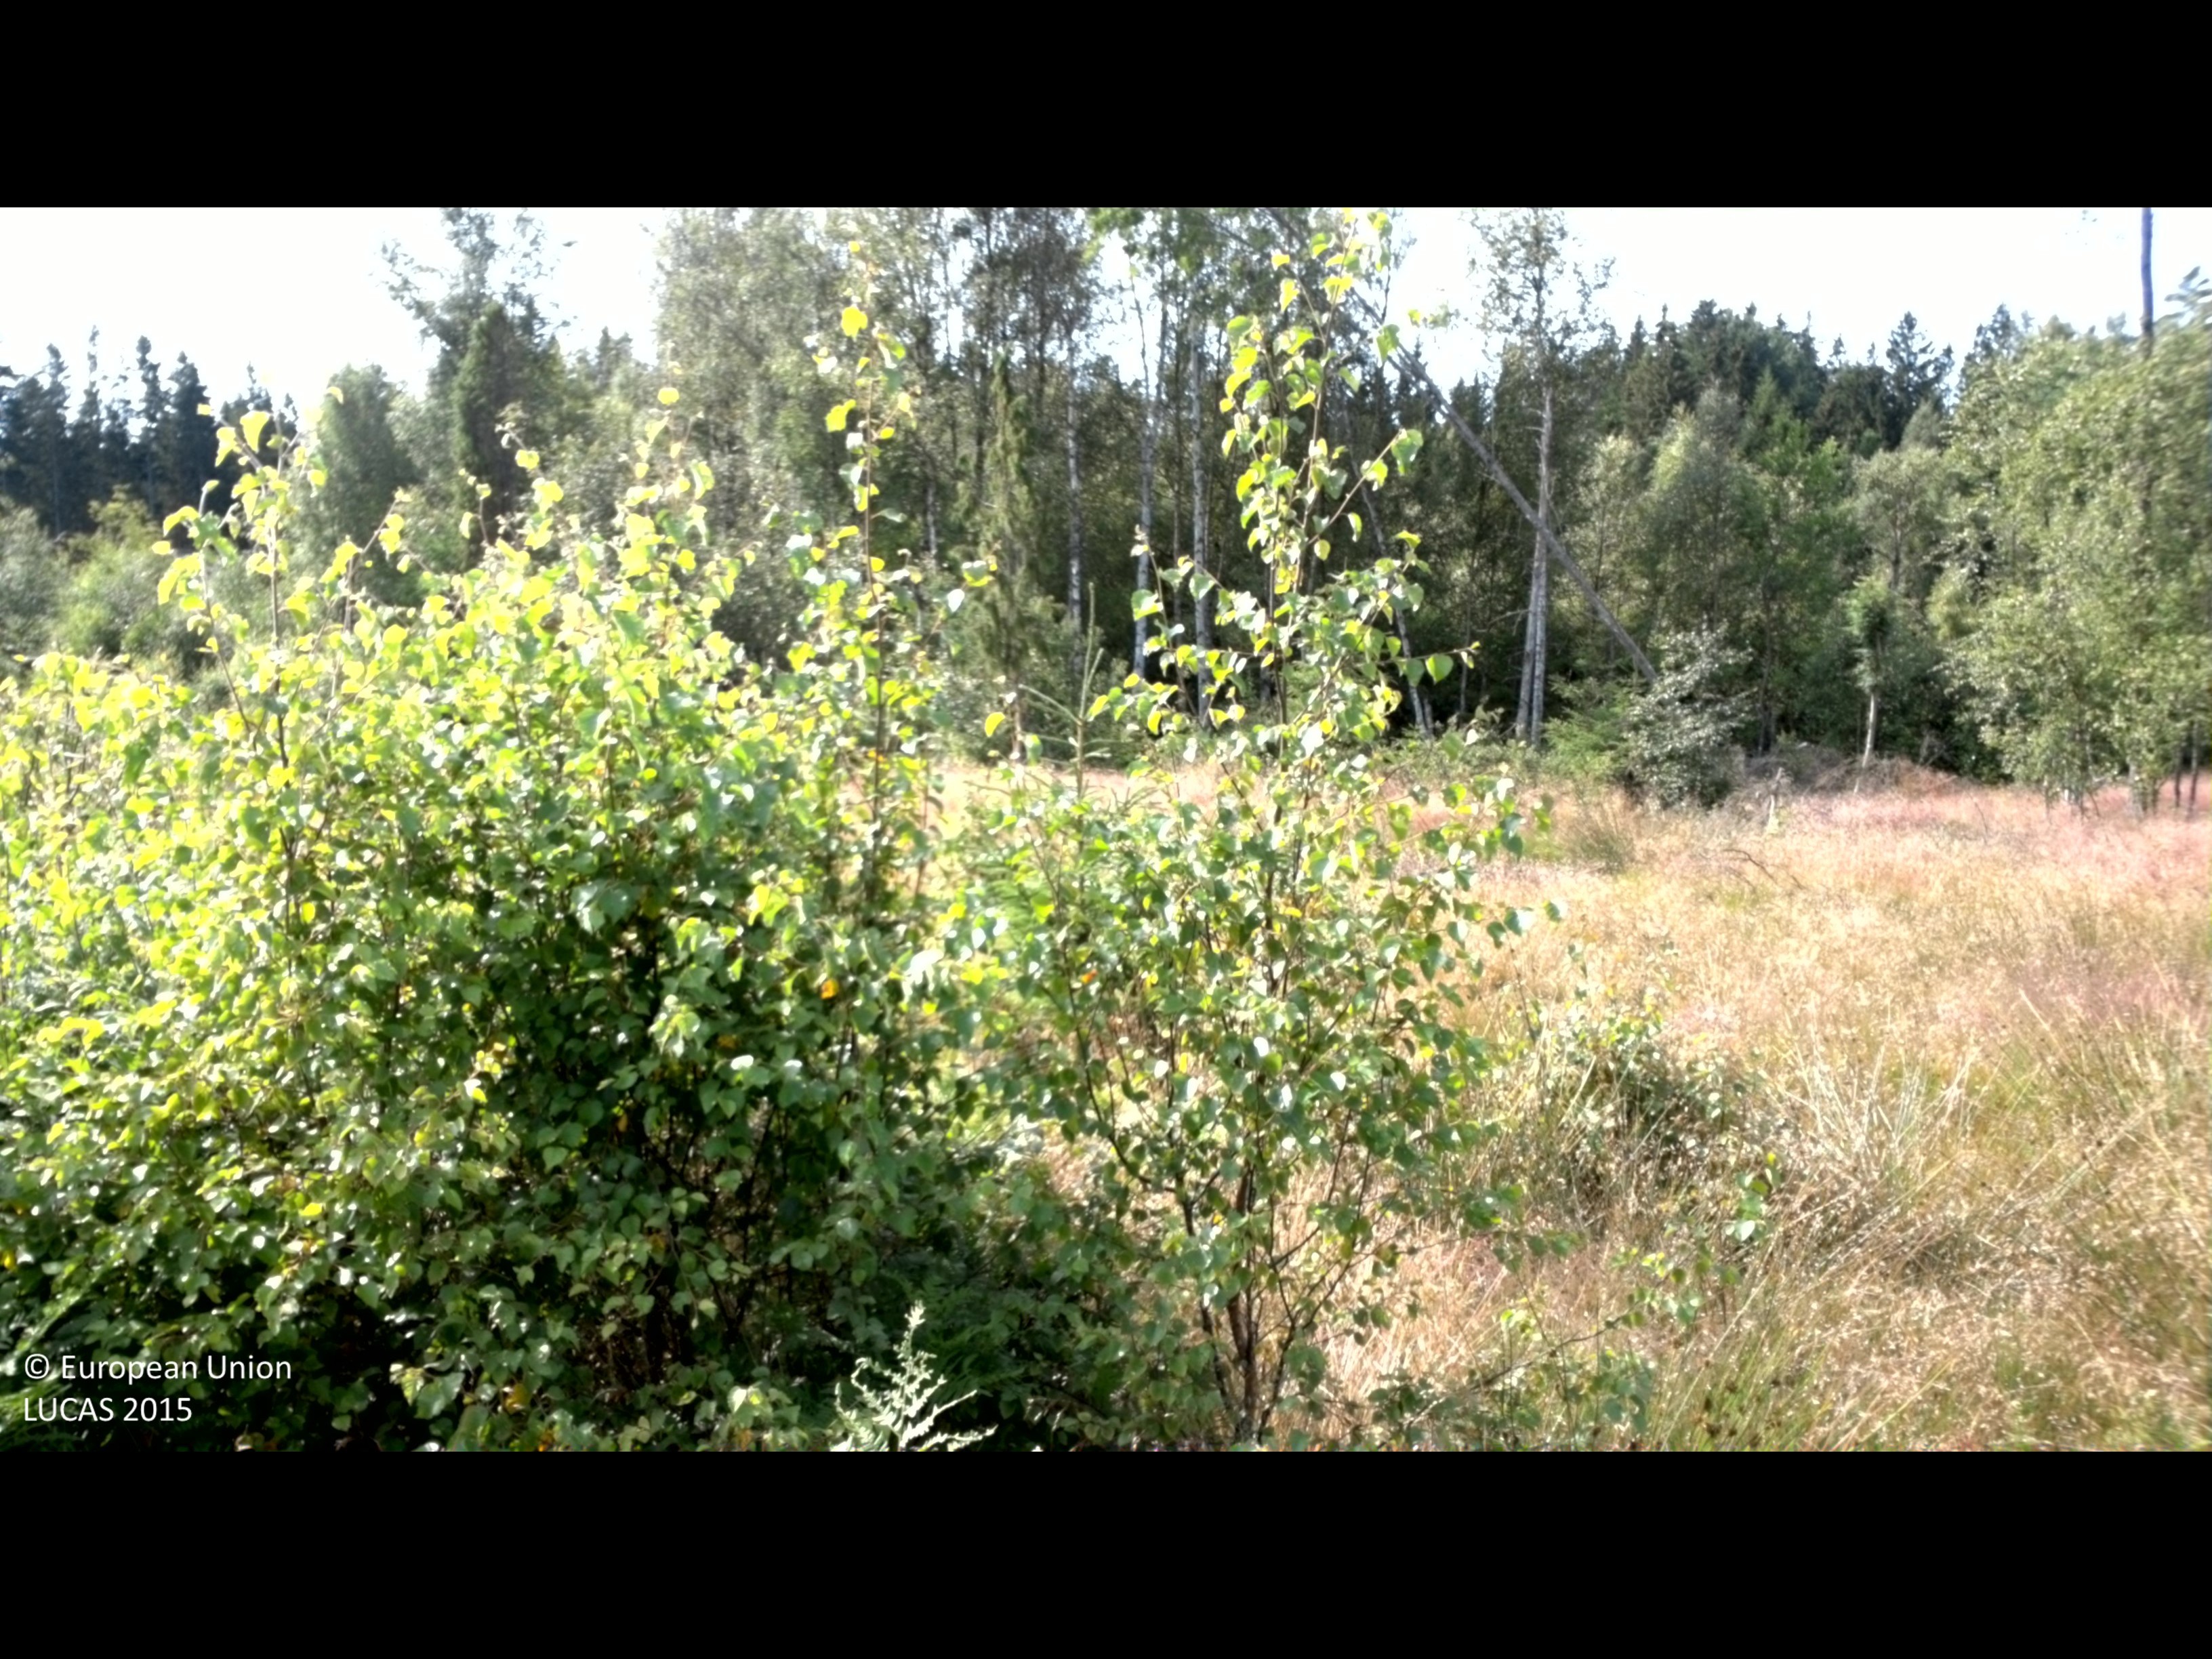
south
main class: Grassland
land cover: Grassland with sparse tree/shrub cover
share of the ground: > 75 %
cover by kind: herbaceous plants 85 %, shrubs 10 %, broadleaved forest trees 5 %
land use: Electricity, gas and thermal power distribution
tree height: < 5 m
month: August
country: SE
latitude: 56.4221
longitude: 14.2936
